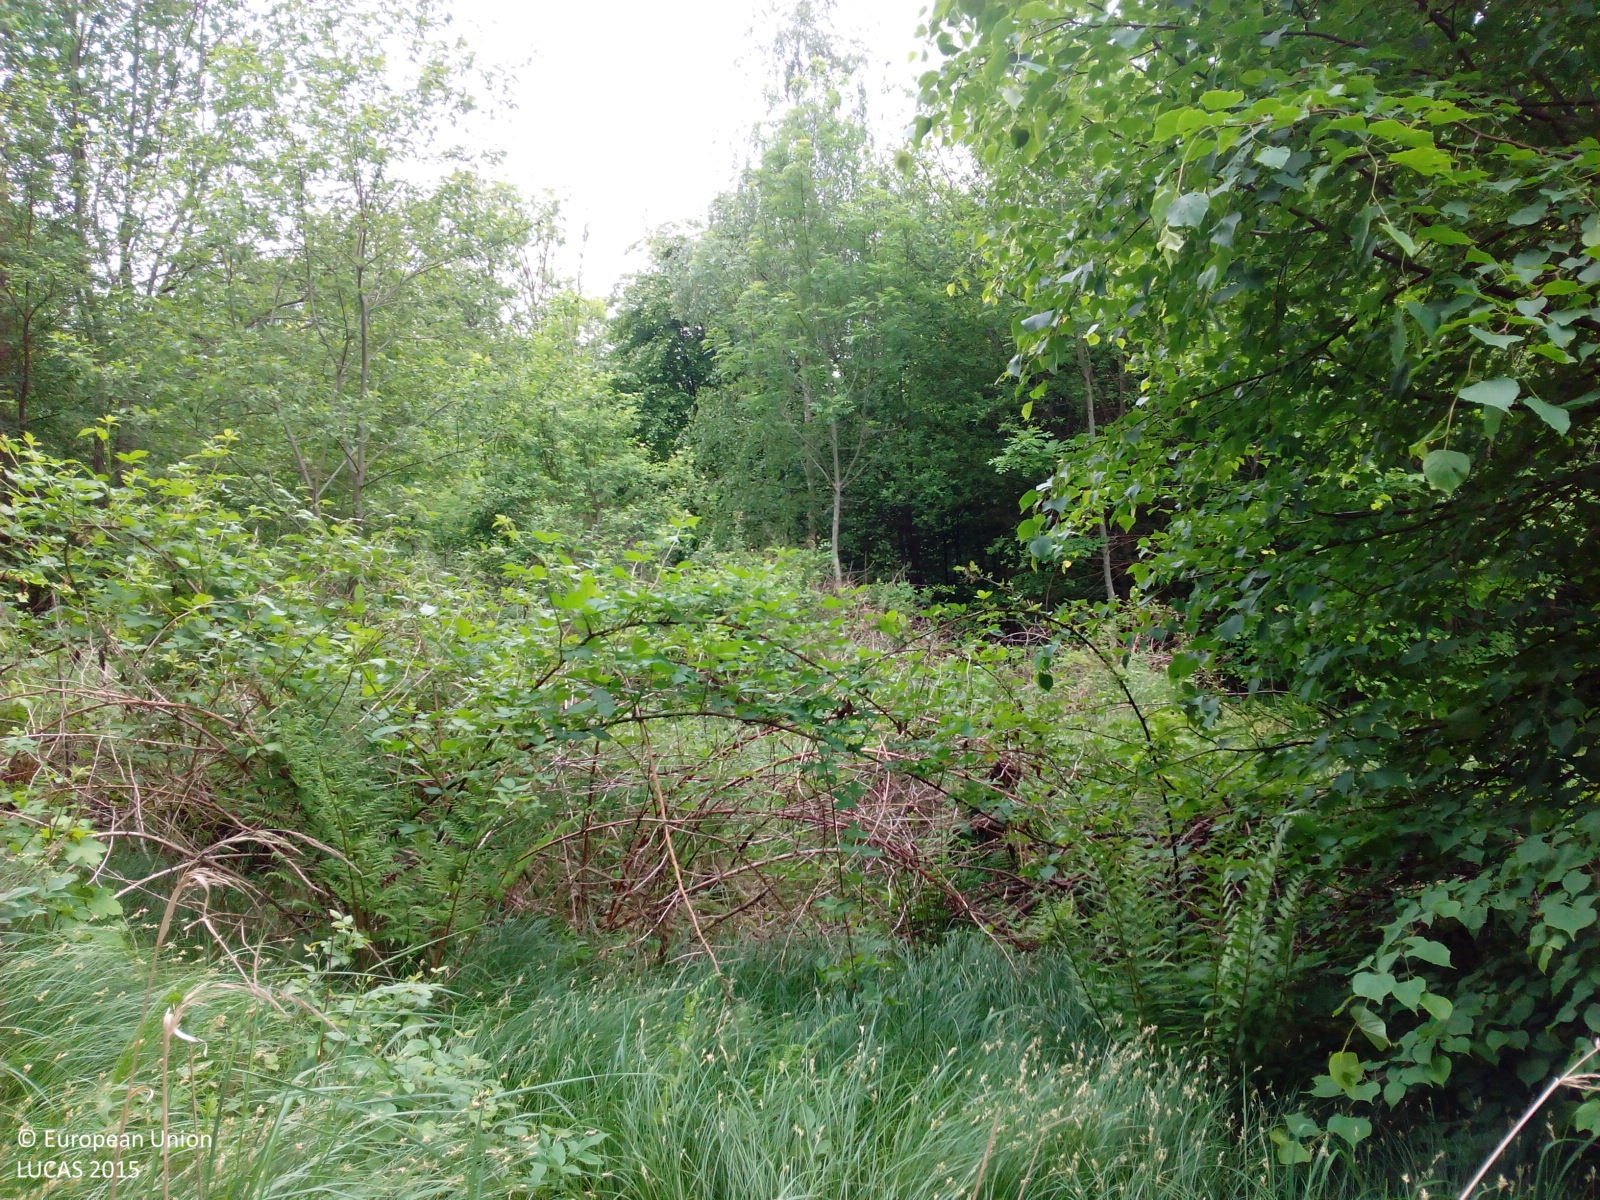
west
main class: Shrubland
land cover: Shrubland with sparse tree cover
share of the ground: > 75 %
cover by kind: herbaceous plants 60 %, shrubs 35 %, broadleaved forest trees 5 %
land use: Forestry
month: May
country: DE
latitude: 48.6352
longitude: 9.3083
